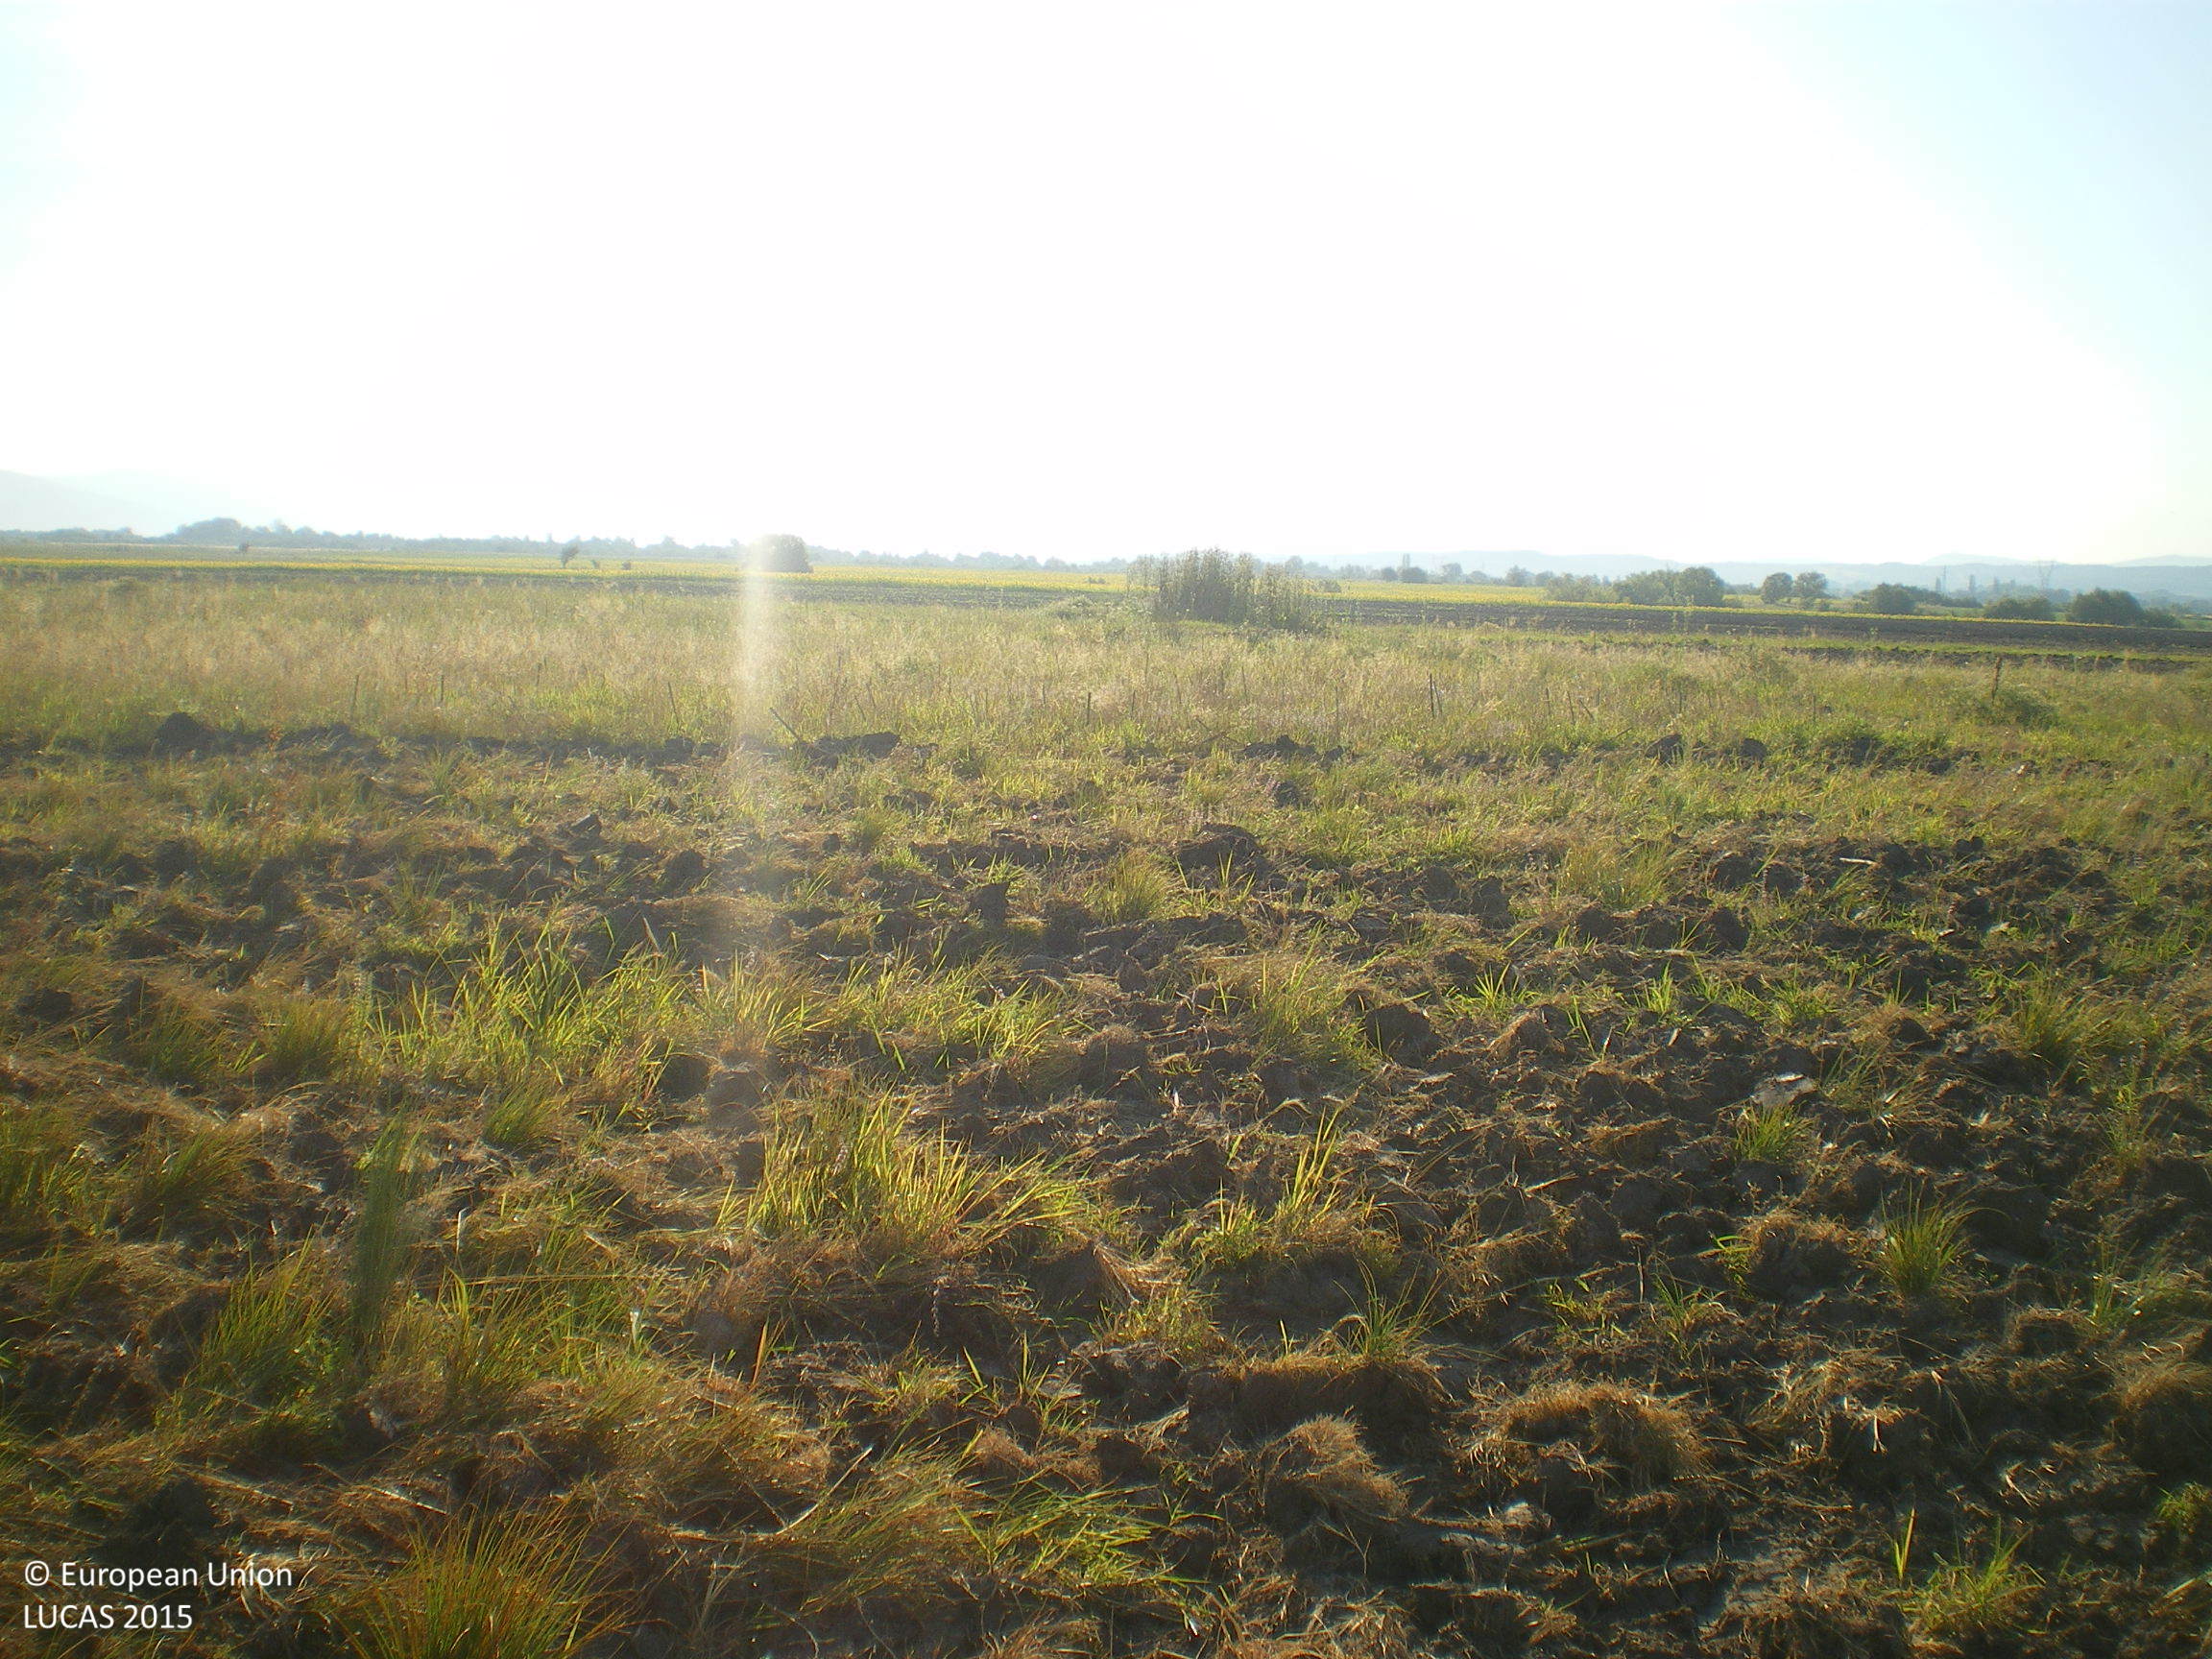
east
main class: Grassland
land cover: Spontaneously vegetated surfaces
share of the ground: 50 - 75 %
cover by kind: herbaceous plants 50 %, unconsolidated bare surface 50 %
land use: Agriculture (excluding fallow land and kitchen gardens)
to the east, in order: Spontaneously vegetated surfaces; Sunflower
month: July
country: BG
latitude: 42.6223
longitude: 25.1712
